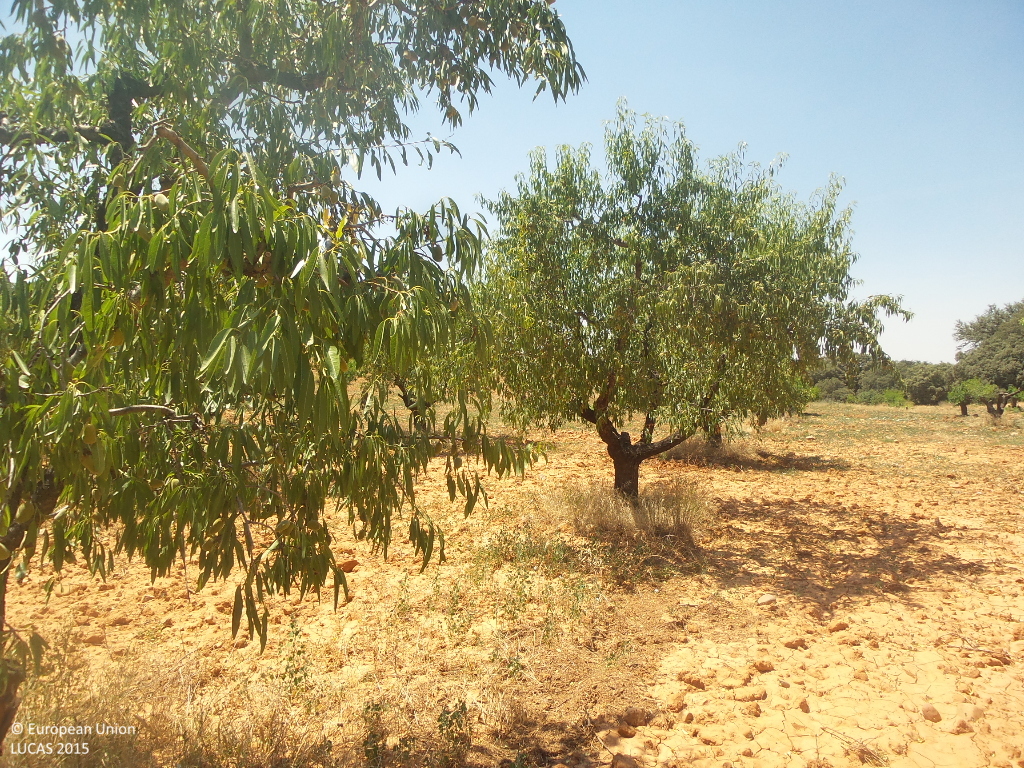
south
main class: Cropland
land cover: Nuts trees
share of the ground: 25 - 50 %
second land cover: Other bare soil
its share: > 75 %
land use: Agriculture (excluding fallow land and kitchen gardens)
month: July
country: ES
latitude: 41.2151
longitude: -1.9421
